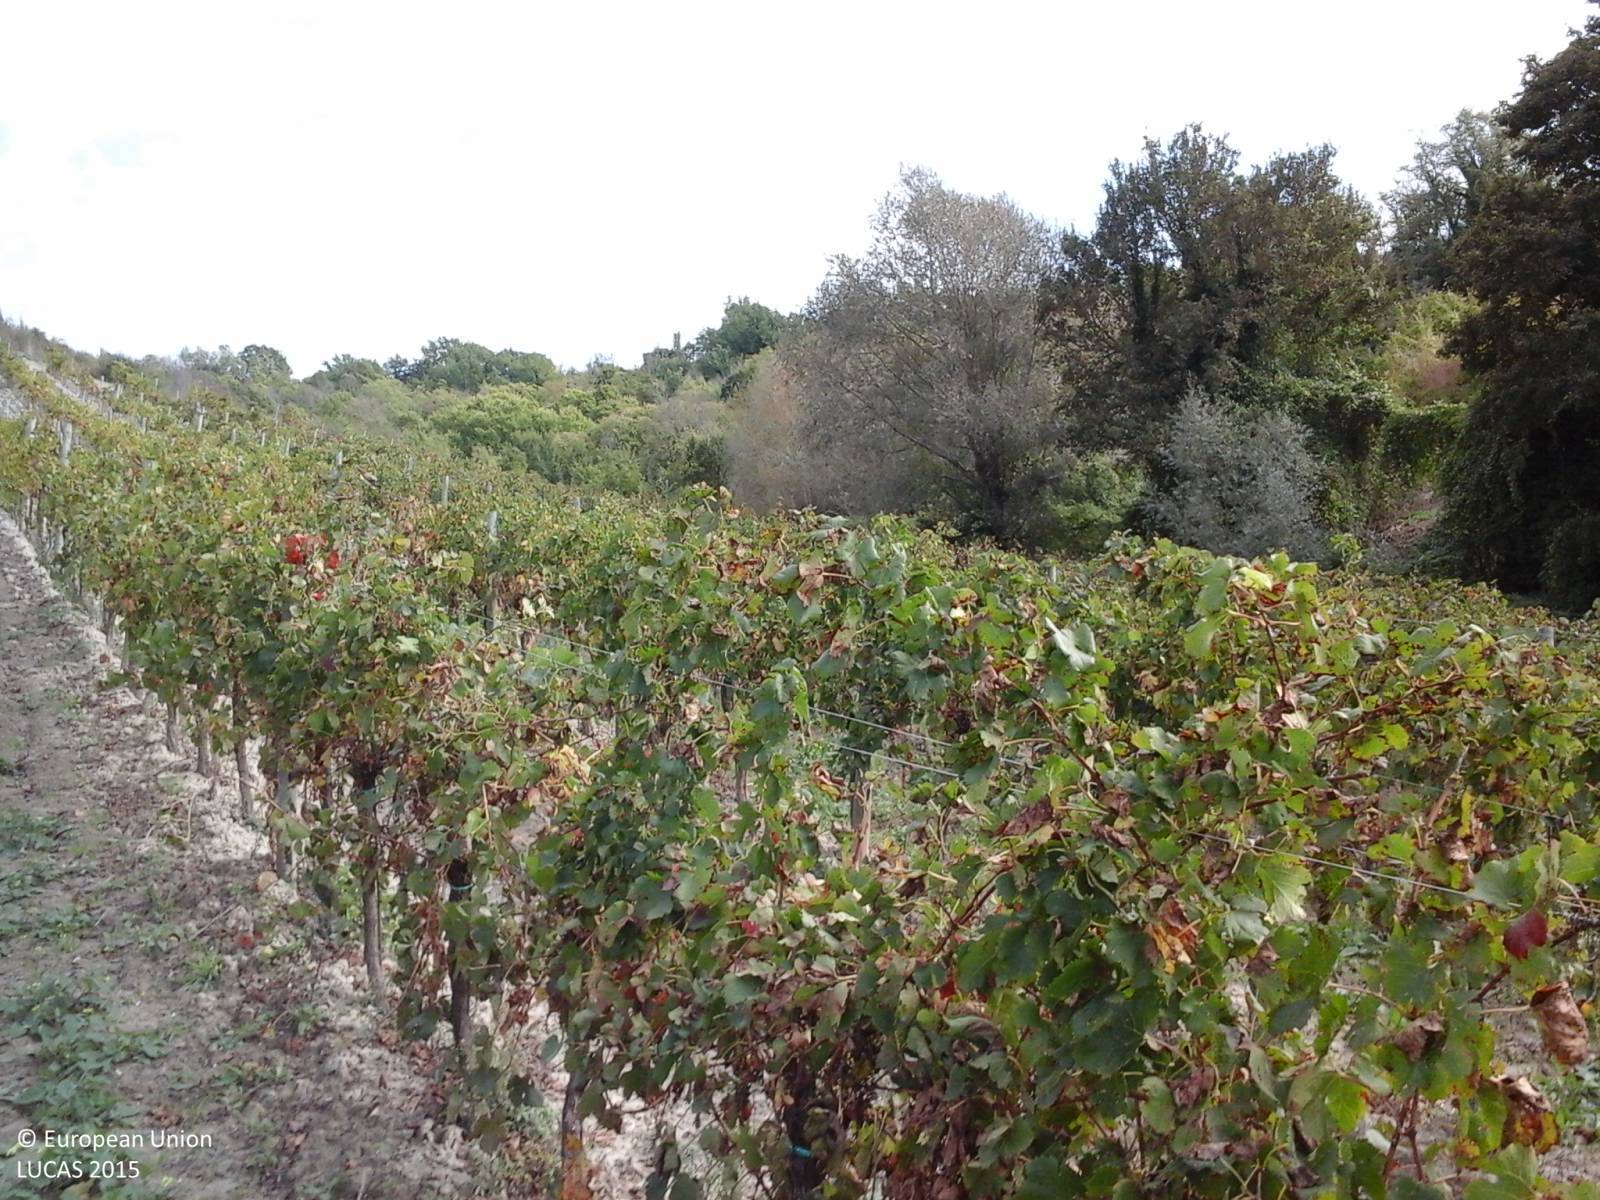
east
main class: Cropland
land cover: Vineyards
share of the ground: > 75 %
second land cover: Other bare soil
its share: > 75 %
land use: Agriculture (excluding fallow land and kitchen gardens)
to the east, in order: Vineyards; Other bare soil; Shrubland without tree cover; Broadleaved woodland
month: October
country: IT
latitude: 42.6827
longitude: 12.2749
